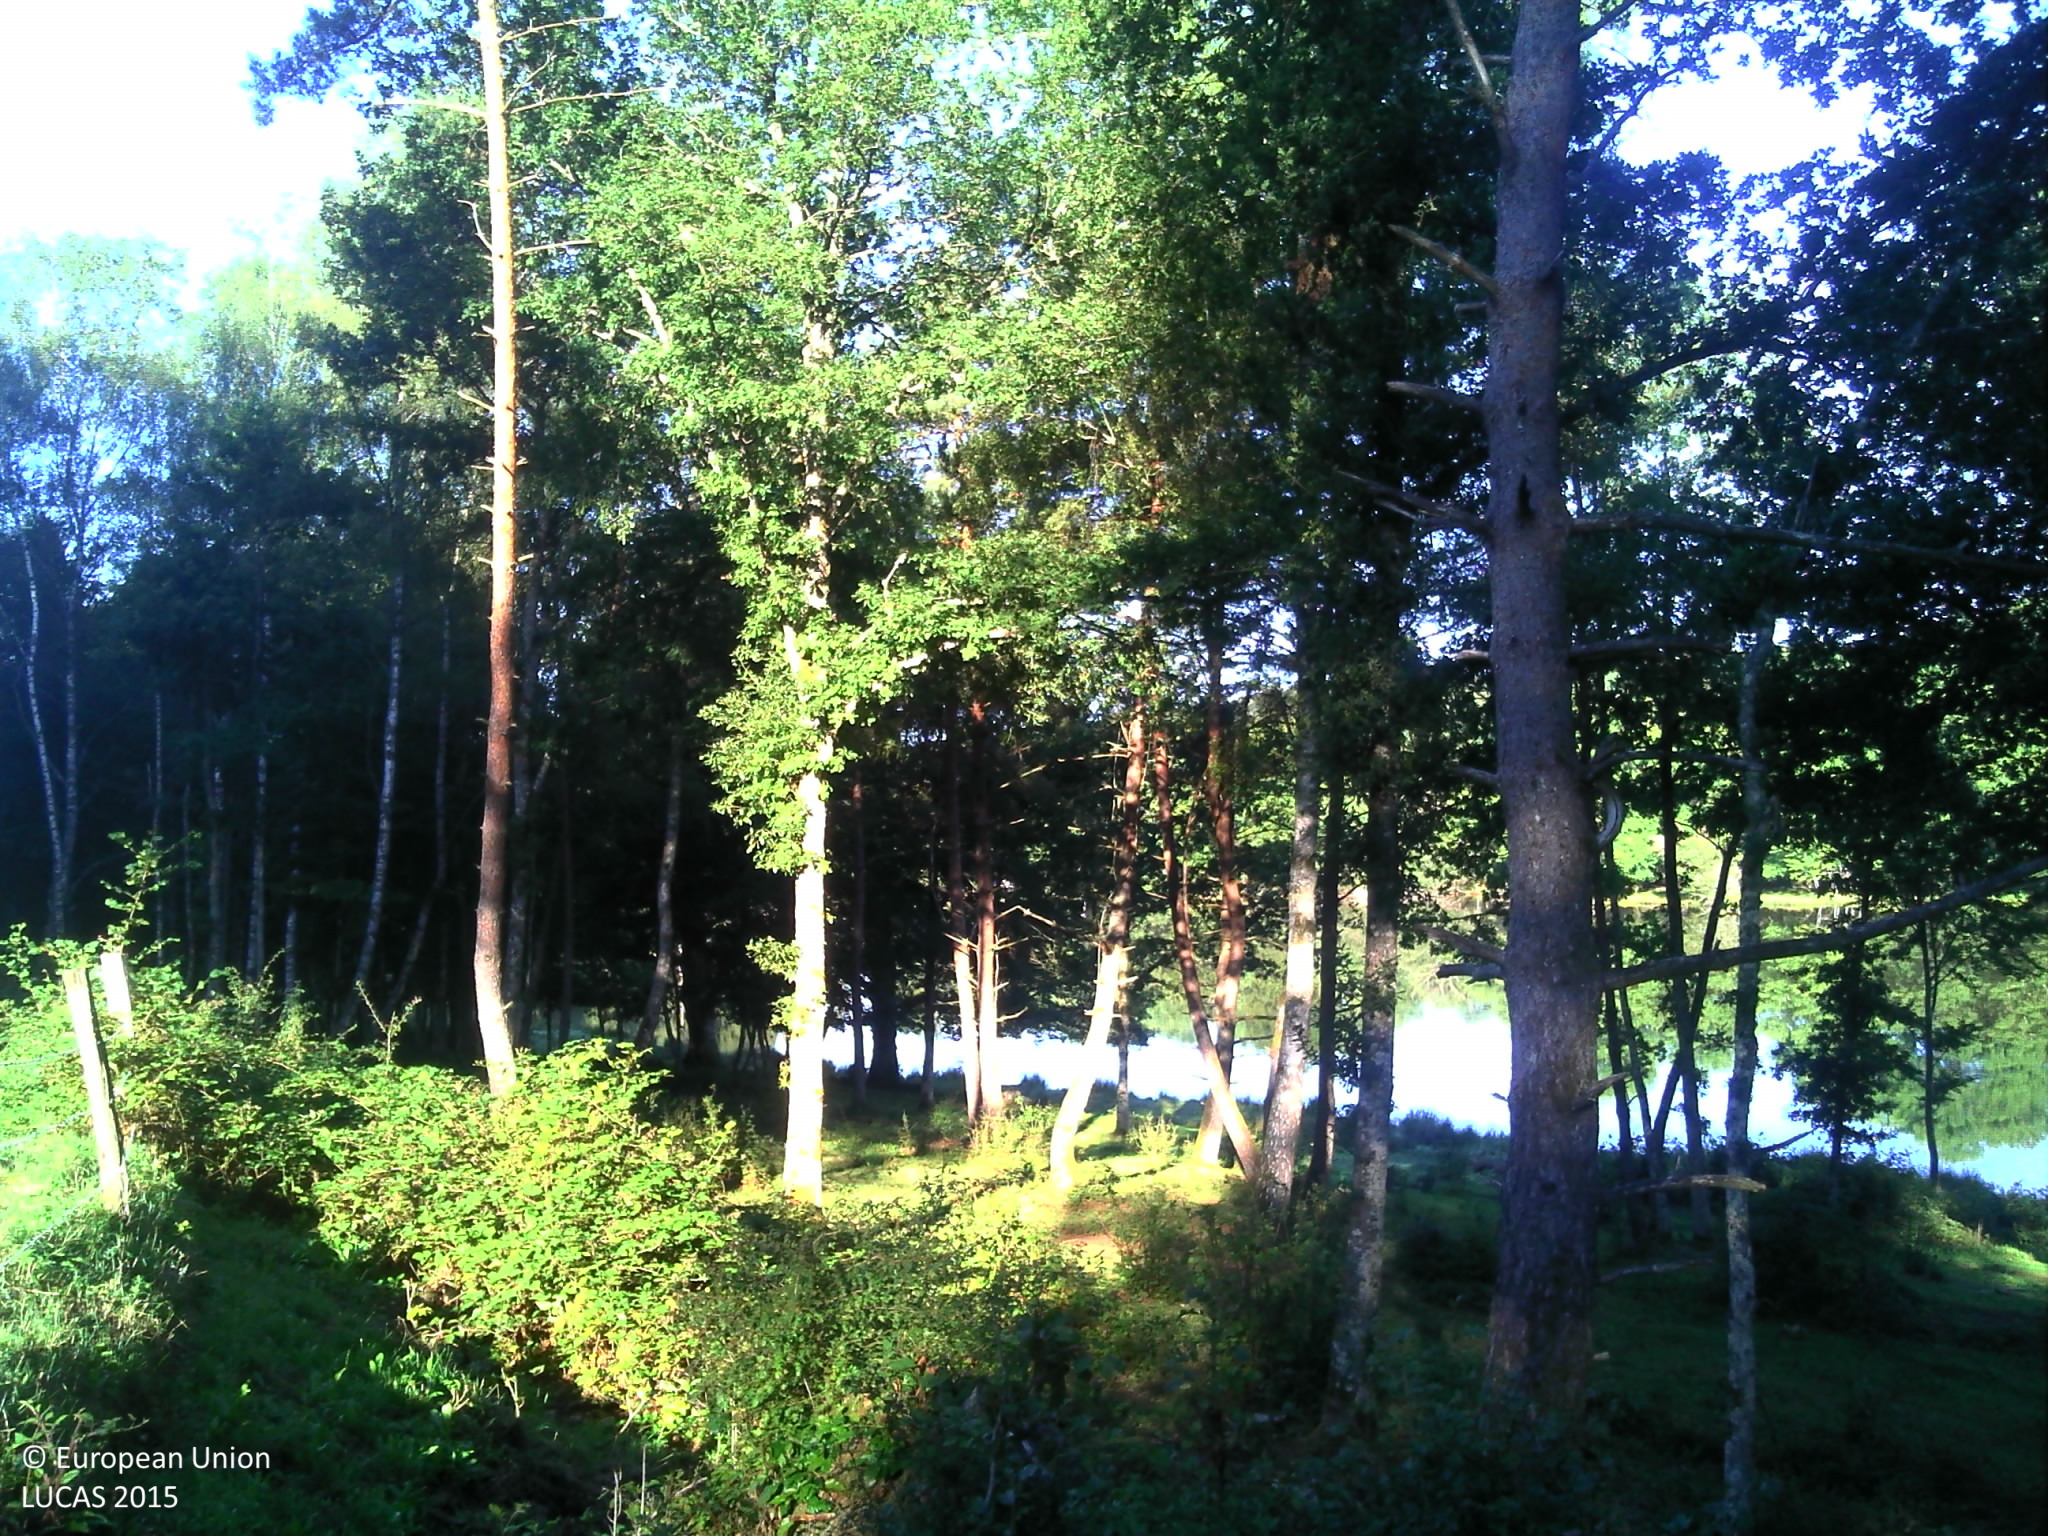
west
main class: Woodland
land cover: Broadleaved woodland
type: acidophilous oak and oak-birch forest
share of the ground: > 75 %
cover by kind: broadleaved forest trees 50 %, herbaceous plants 40 %, shrubs 5 %, lichens and mosses 5 %
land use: Agriculture (excluding fallow land and kitchen gardens)
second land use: Forestry
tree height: > 5 m
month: August
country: FR
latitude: 45.7531
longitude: 2.3738
